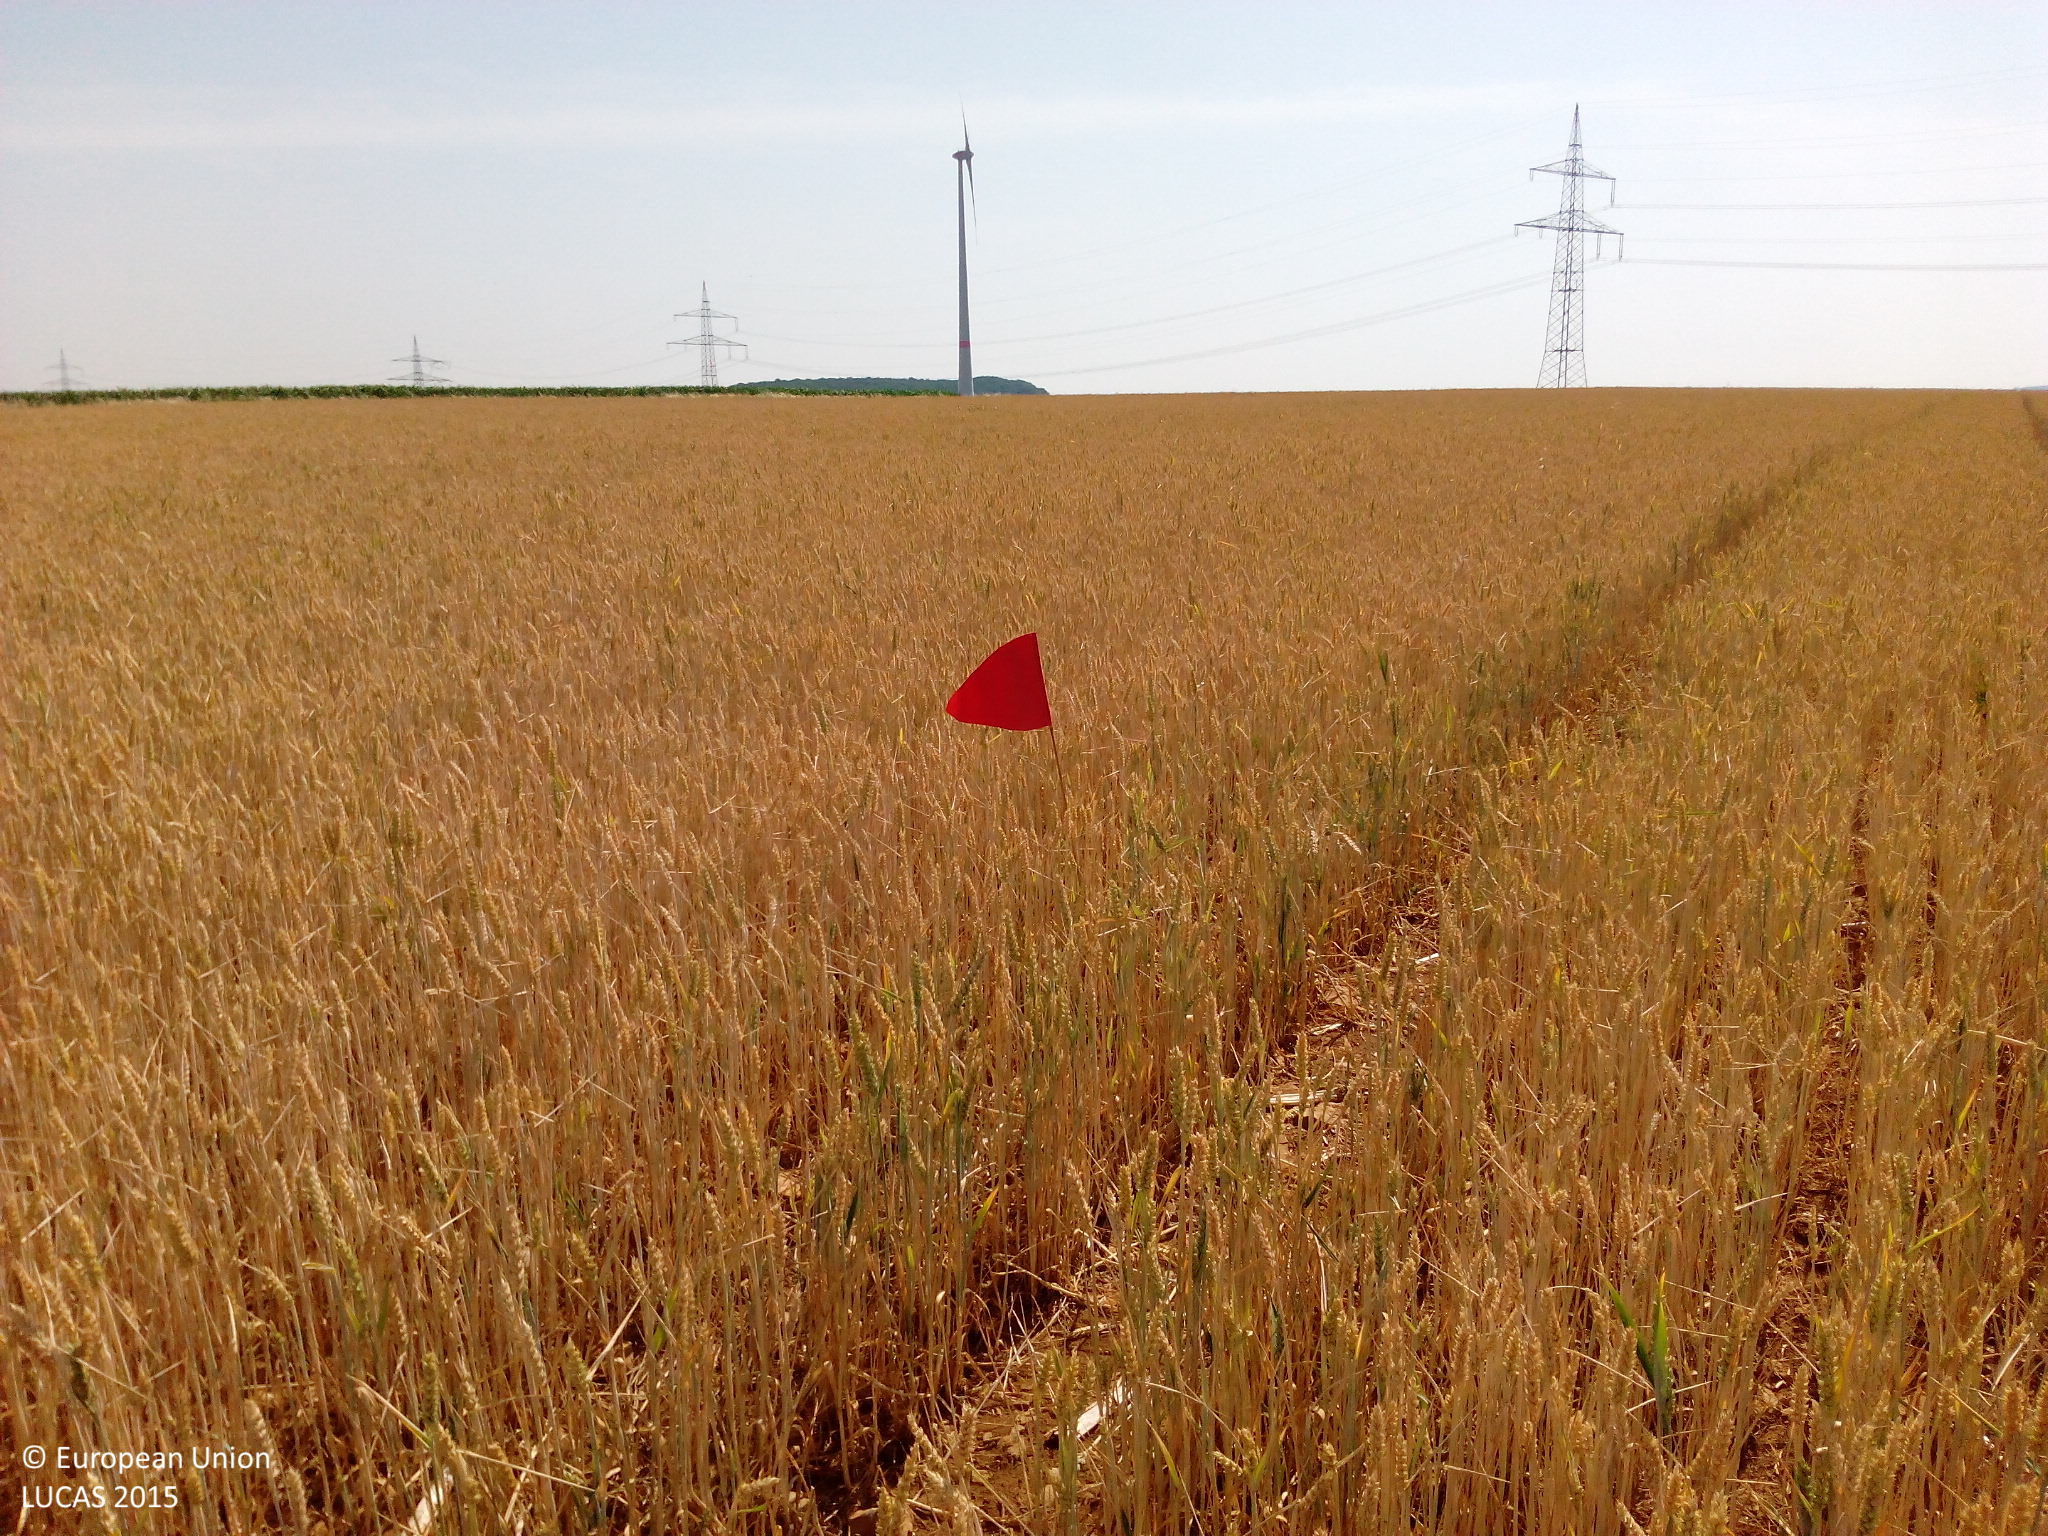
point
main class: Cropland
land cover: Common wheat
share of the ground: > 75 %
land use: Agriculture (excluding fallow land and kitchen gardens)
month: July
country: DE
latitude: 49.5188
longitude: 9.9033
